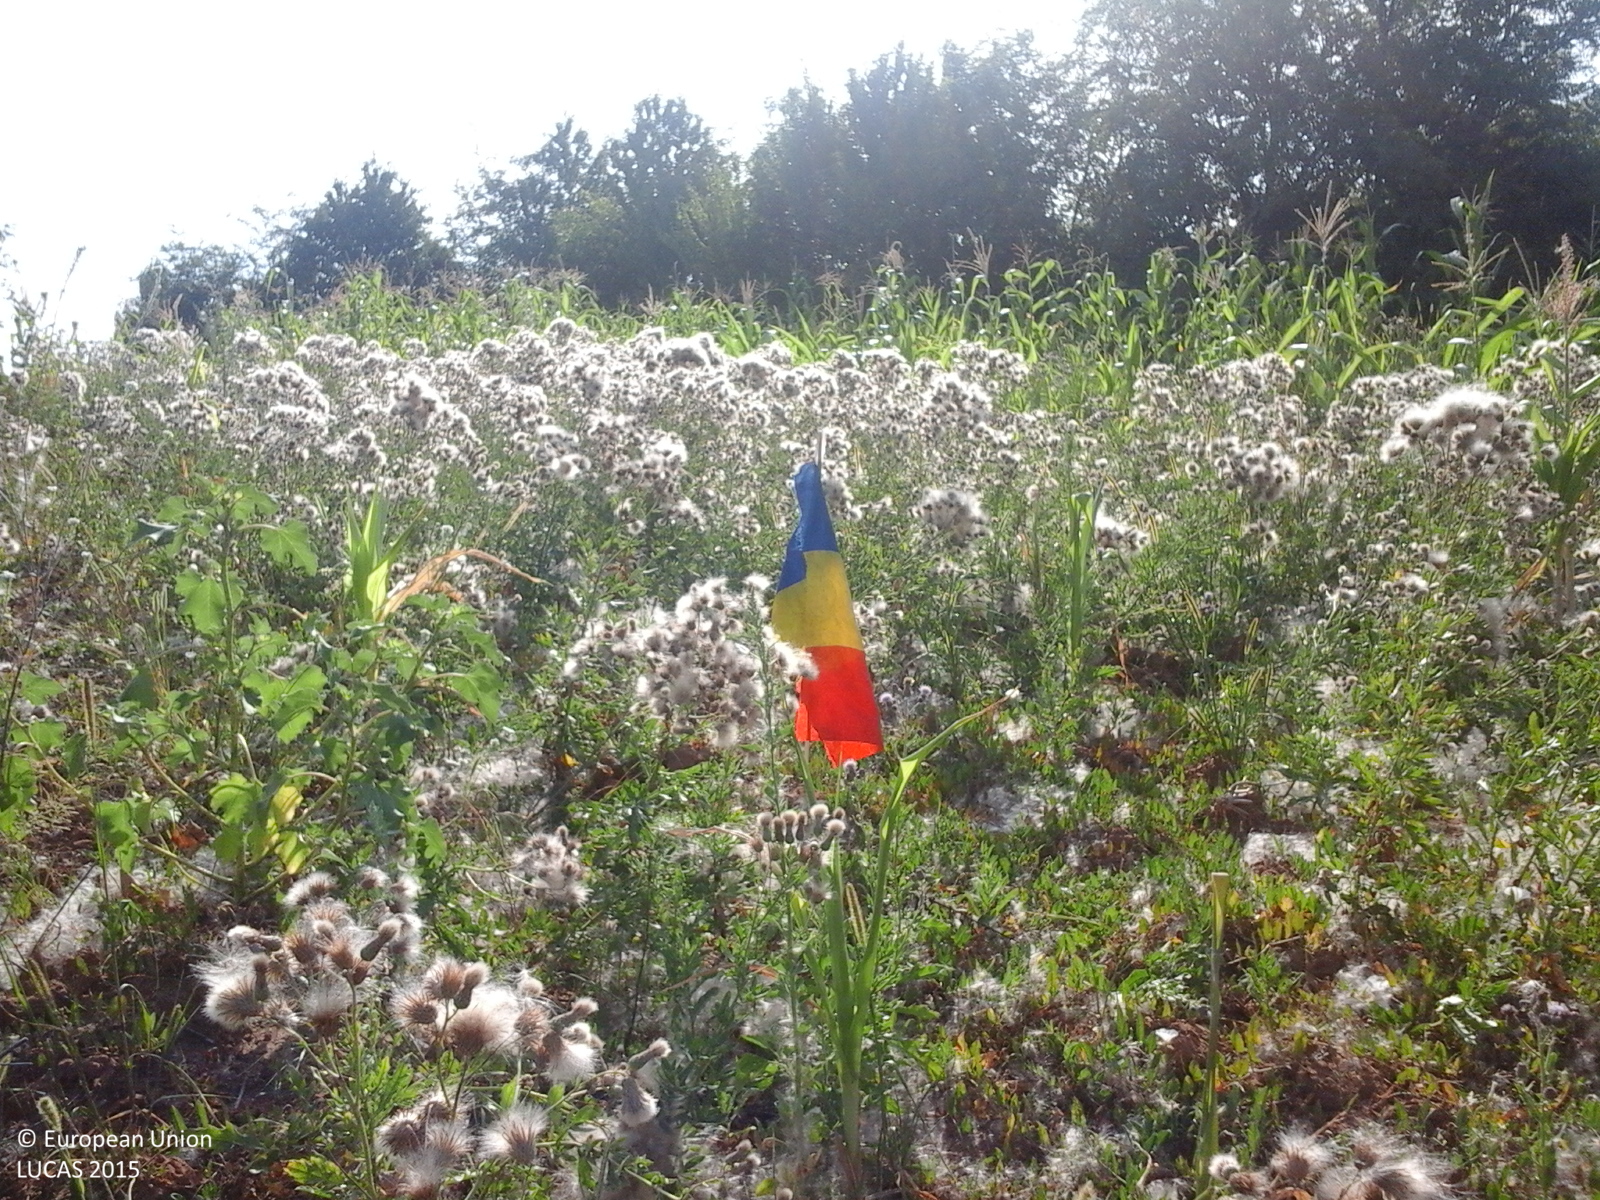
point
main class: Grassland
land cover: Spontaneously vegetated surfaces
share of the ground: > 75 %
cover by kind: herbaceous plants 90 %, unconsolidated bare surface 10 %
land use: Fallow land
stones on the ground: < 10 %
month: July
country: RO
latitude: 46.0785
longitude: 27.7926
